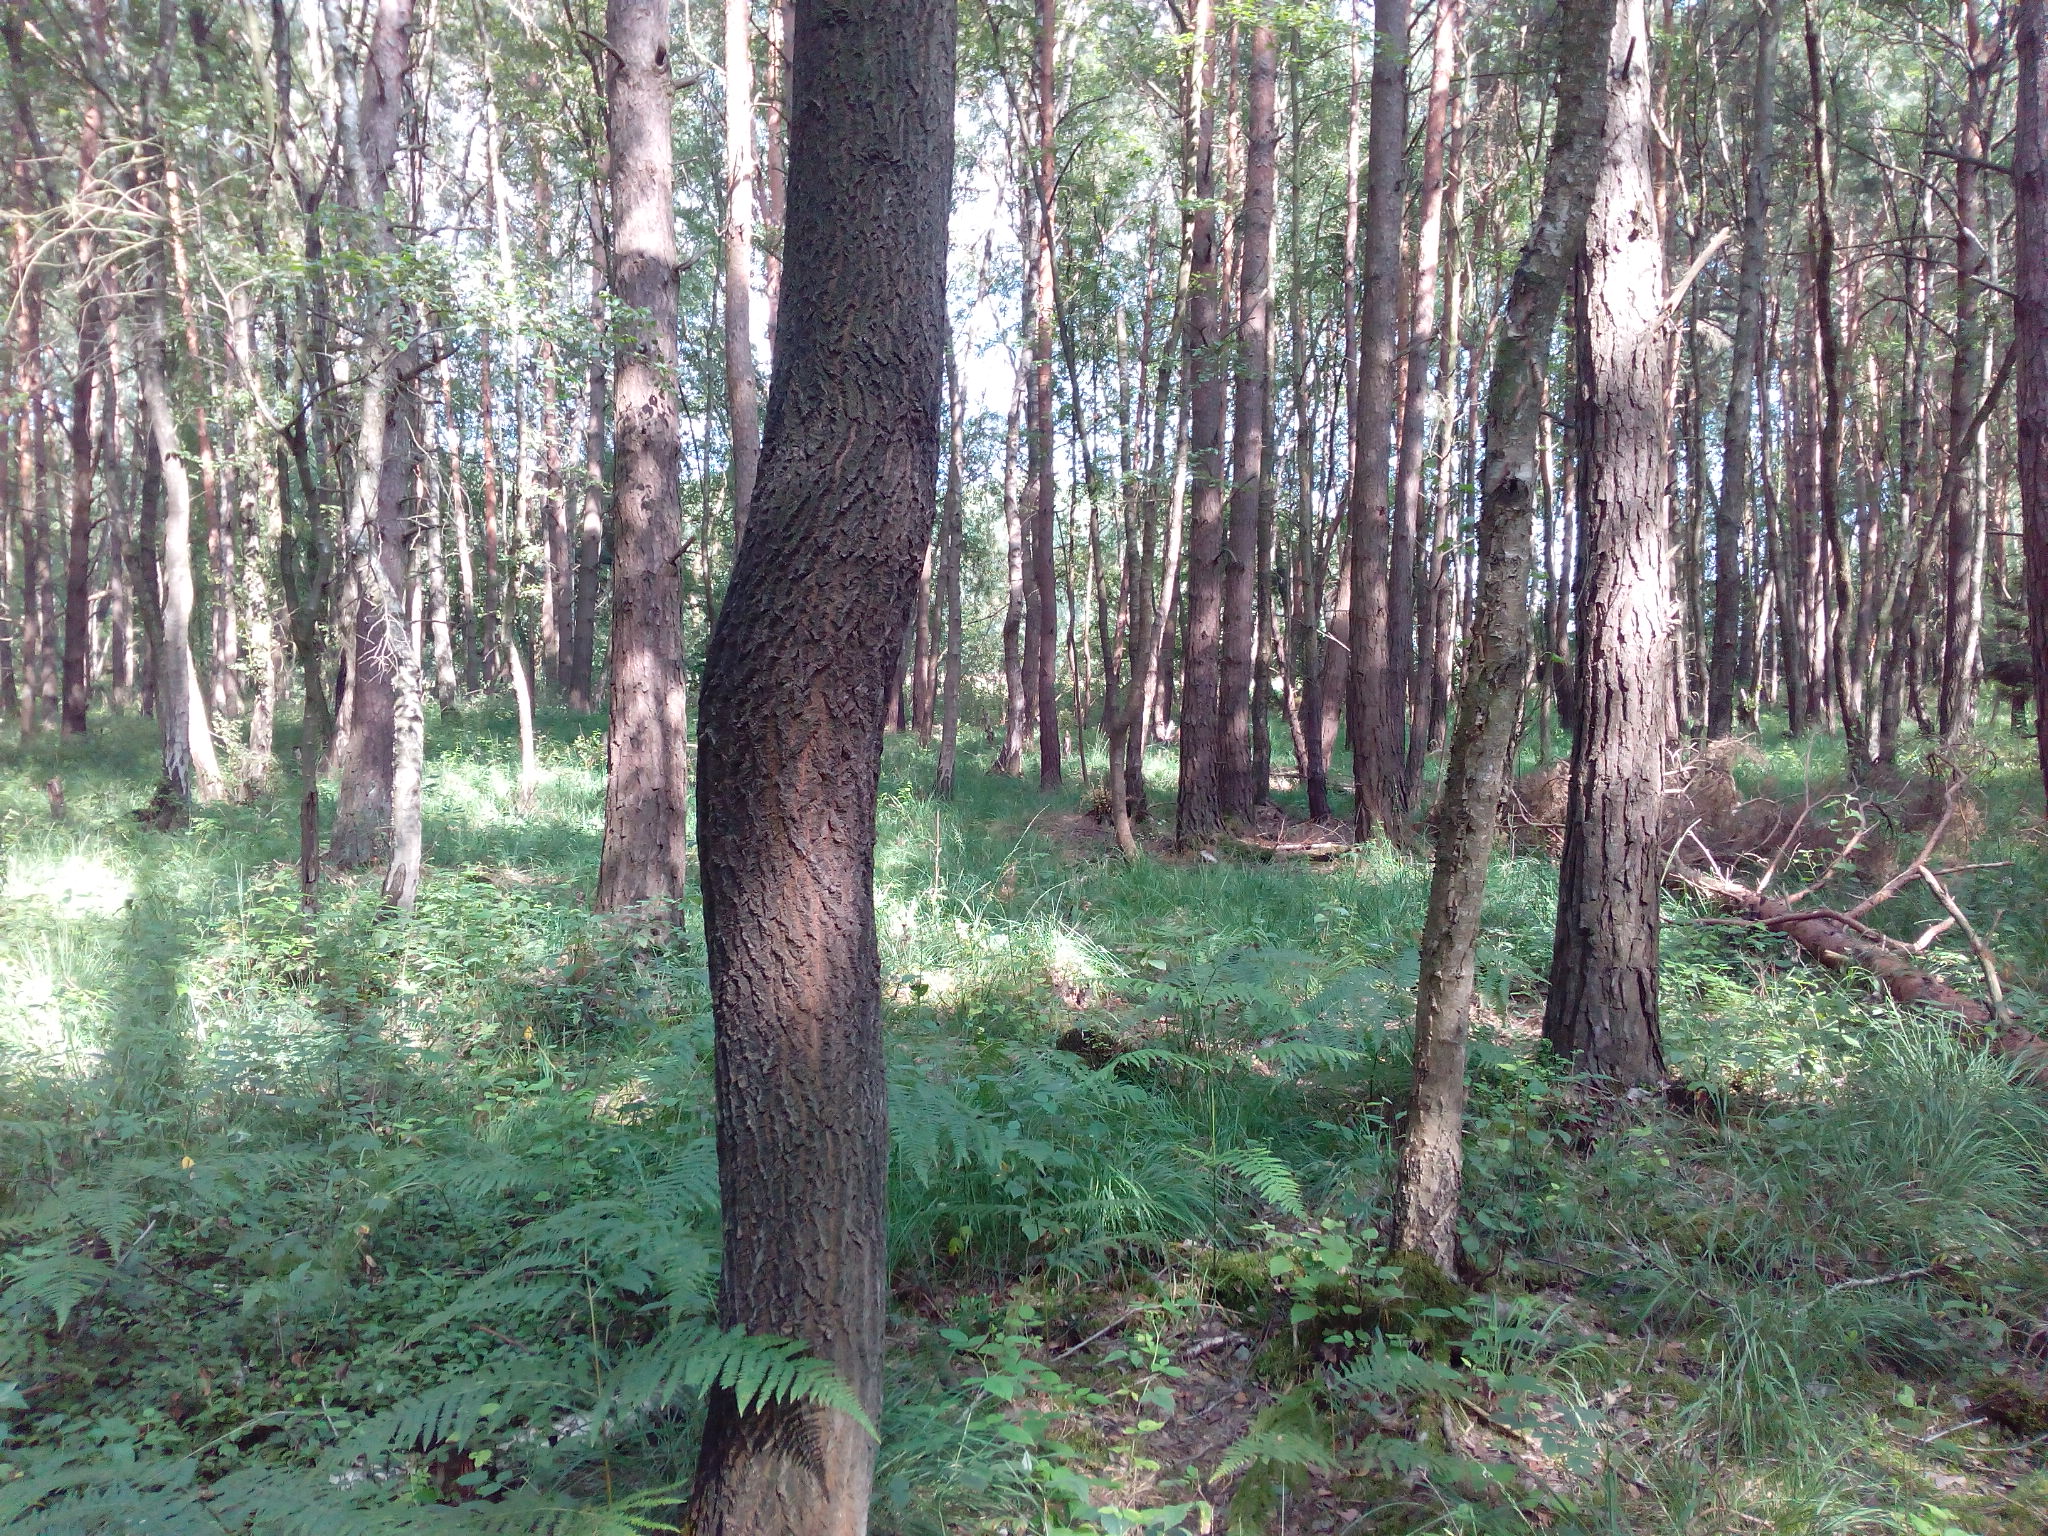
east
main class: Woodland
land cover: Pine dominated mixed woodland
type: hemiboreal forest and nemoral coniferous forest and mixed broadleaved-coniferous forest
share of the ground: > 75 %
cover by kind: broadleaved forest trees 50 %, coniferous forest trees 45 %, herbaceous plants 5 %
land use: Forestry
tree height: > 5 m
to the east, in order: Pine dominated mixed woodland; Ditches and canals; Fences; Grassland without tree/shrub cover; Ditches and canals; Broadleaved woodland; Grassland without tree/shrub cover
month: August
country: DE
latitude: 52.4134
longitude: 9.9265
